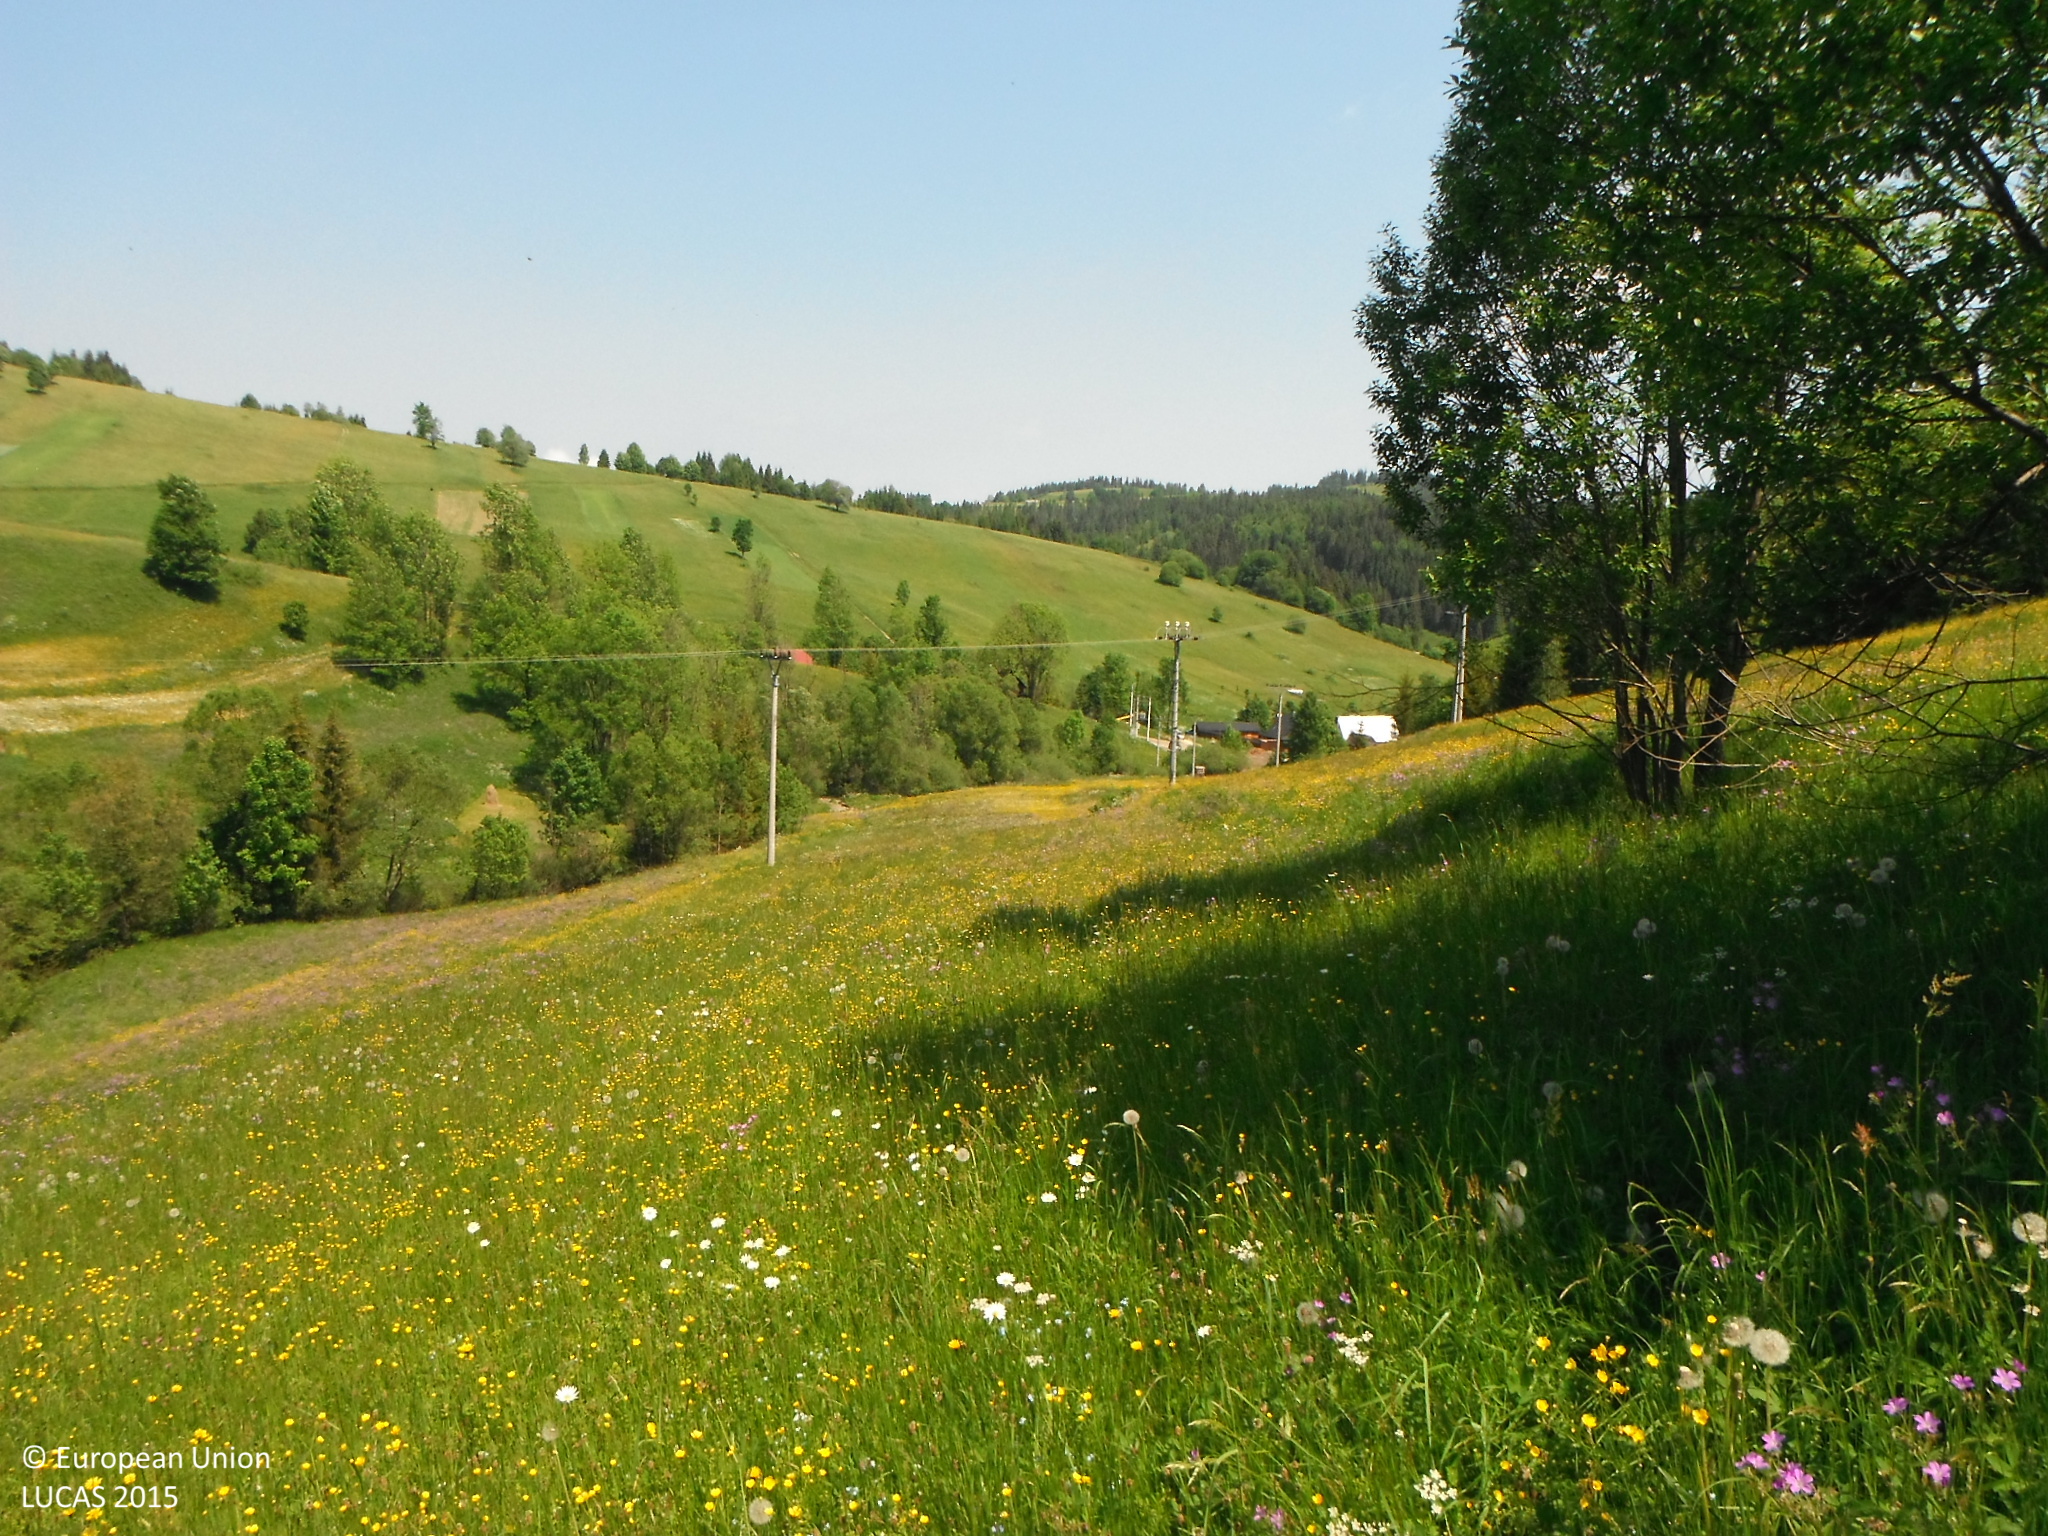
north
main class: Grassland
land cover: Grassland with sparse tree/shrub cover
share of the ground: > 75 %
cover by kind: herbaceous plants 90 %, broadleaved forest trees 5 %, shrubs 5 %
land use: Agriculture (excluding fallow land and kitchen gardens)
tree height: < 5 m
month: June
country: SK
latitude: 49.3266
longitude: 20.2015
